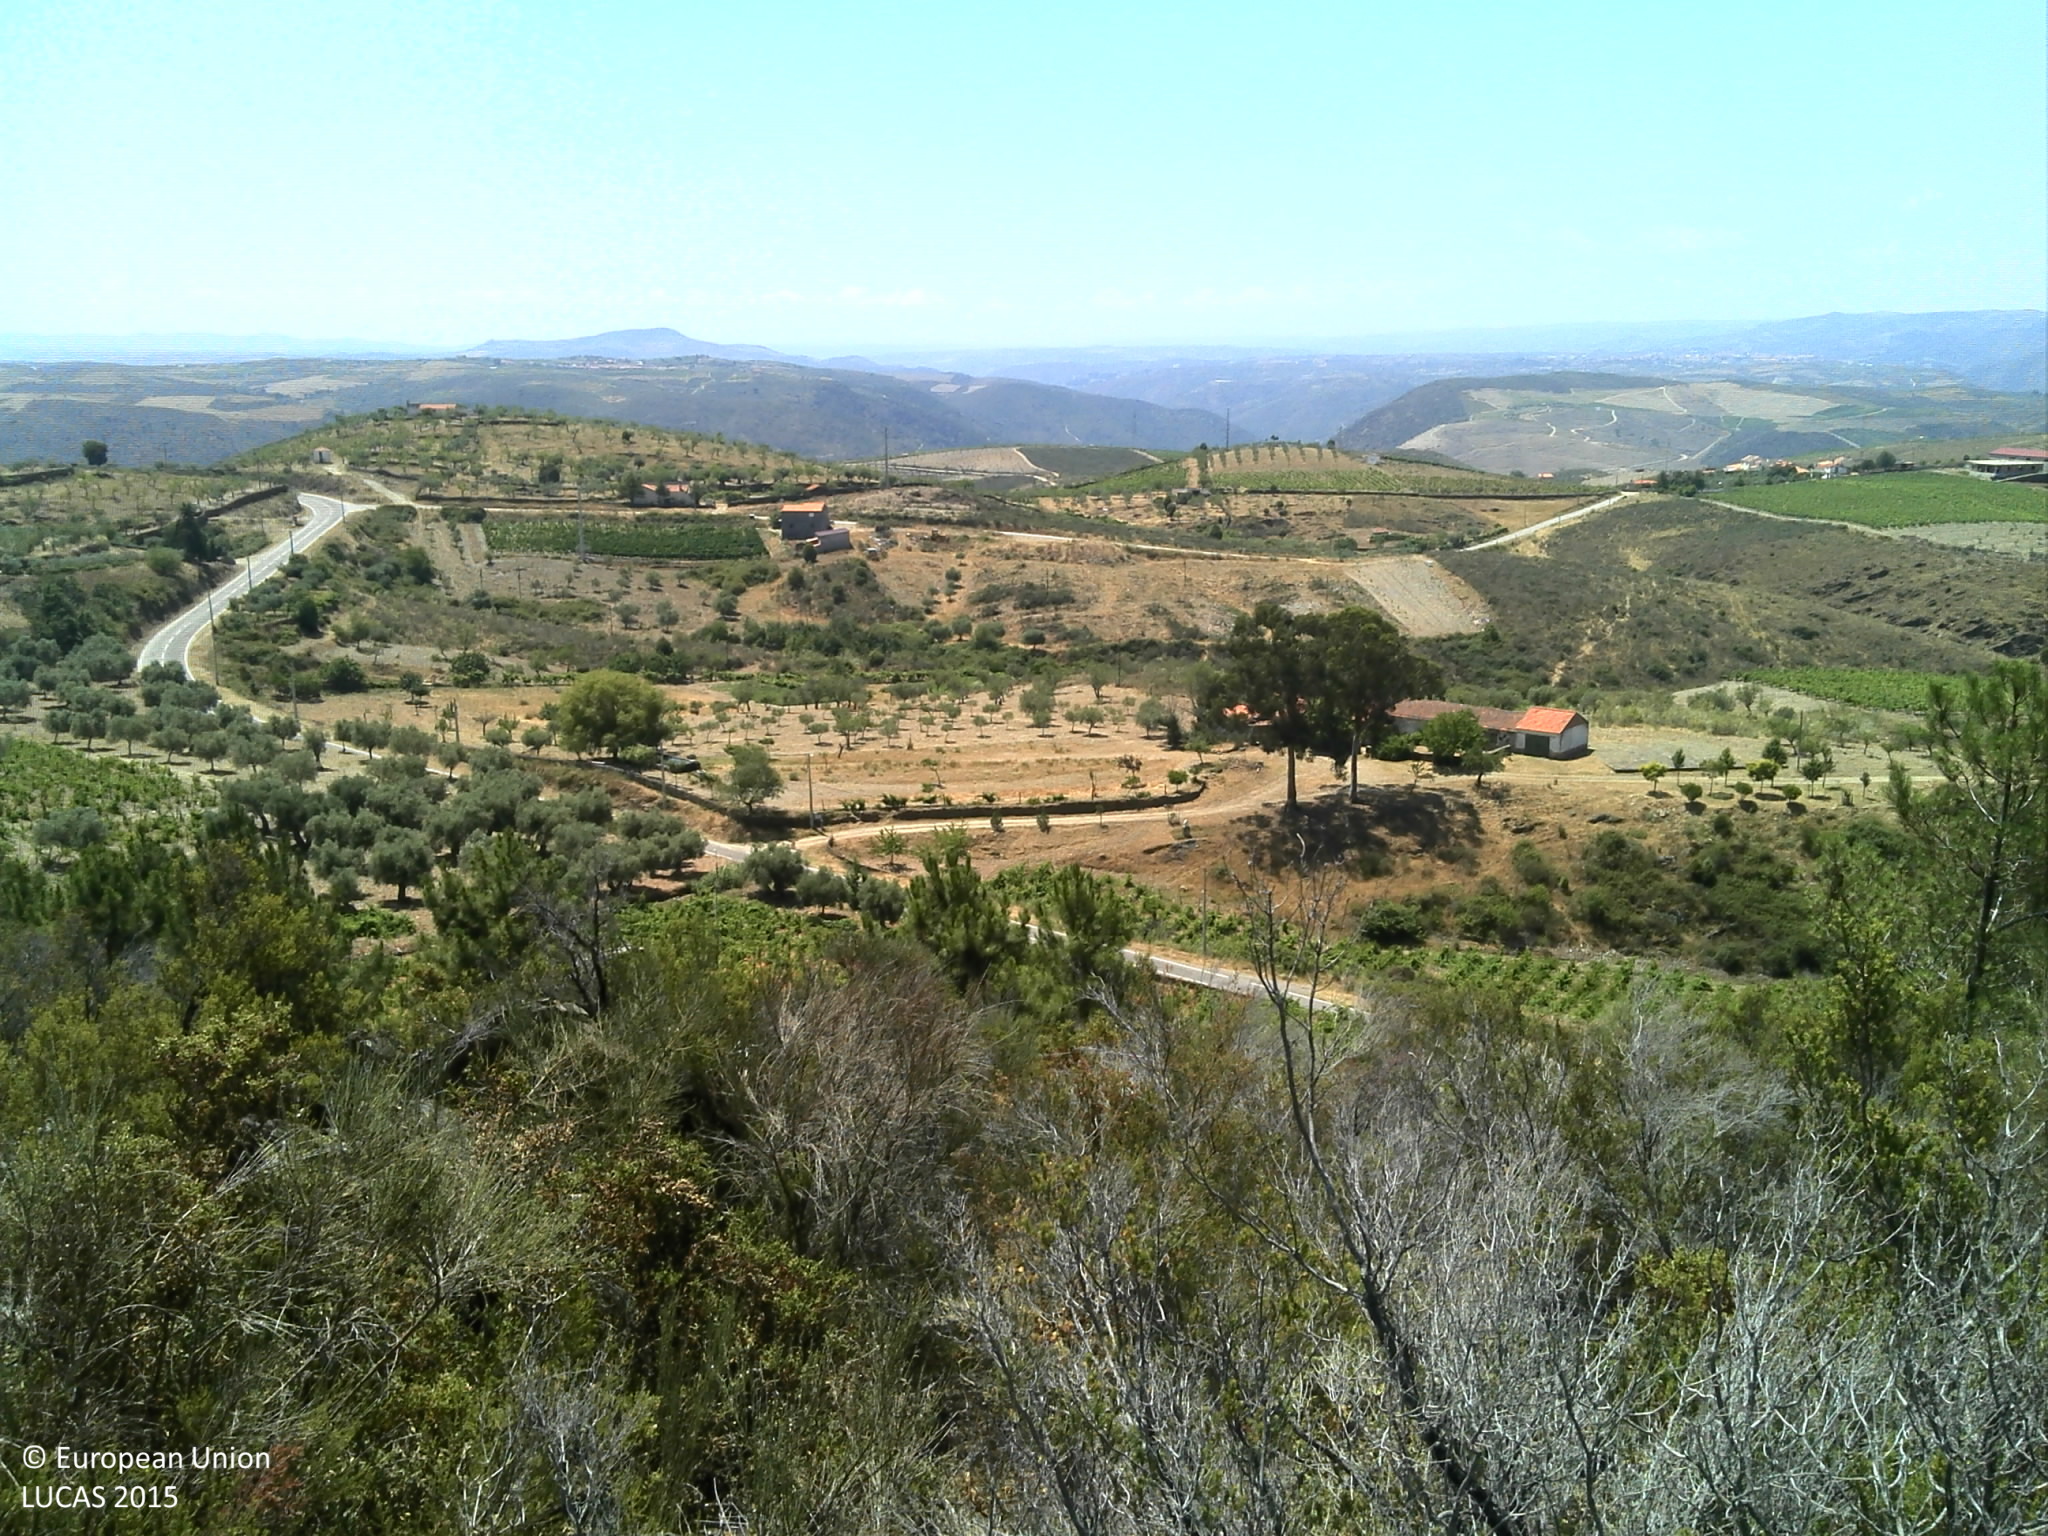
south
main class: Shrubland
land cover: Shrubland without tree cover
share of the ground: > 75 %
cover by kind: shrubs 90 %, consolidated bare surface 5 %, unconsolidated bare surface 5 %
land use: Semi-natural and natural areas not in use
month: June
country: PT
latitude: 41.1558
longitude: -7.0682
